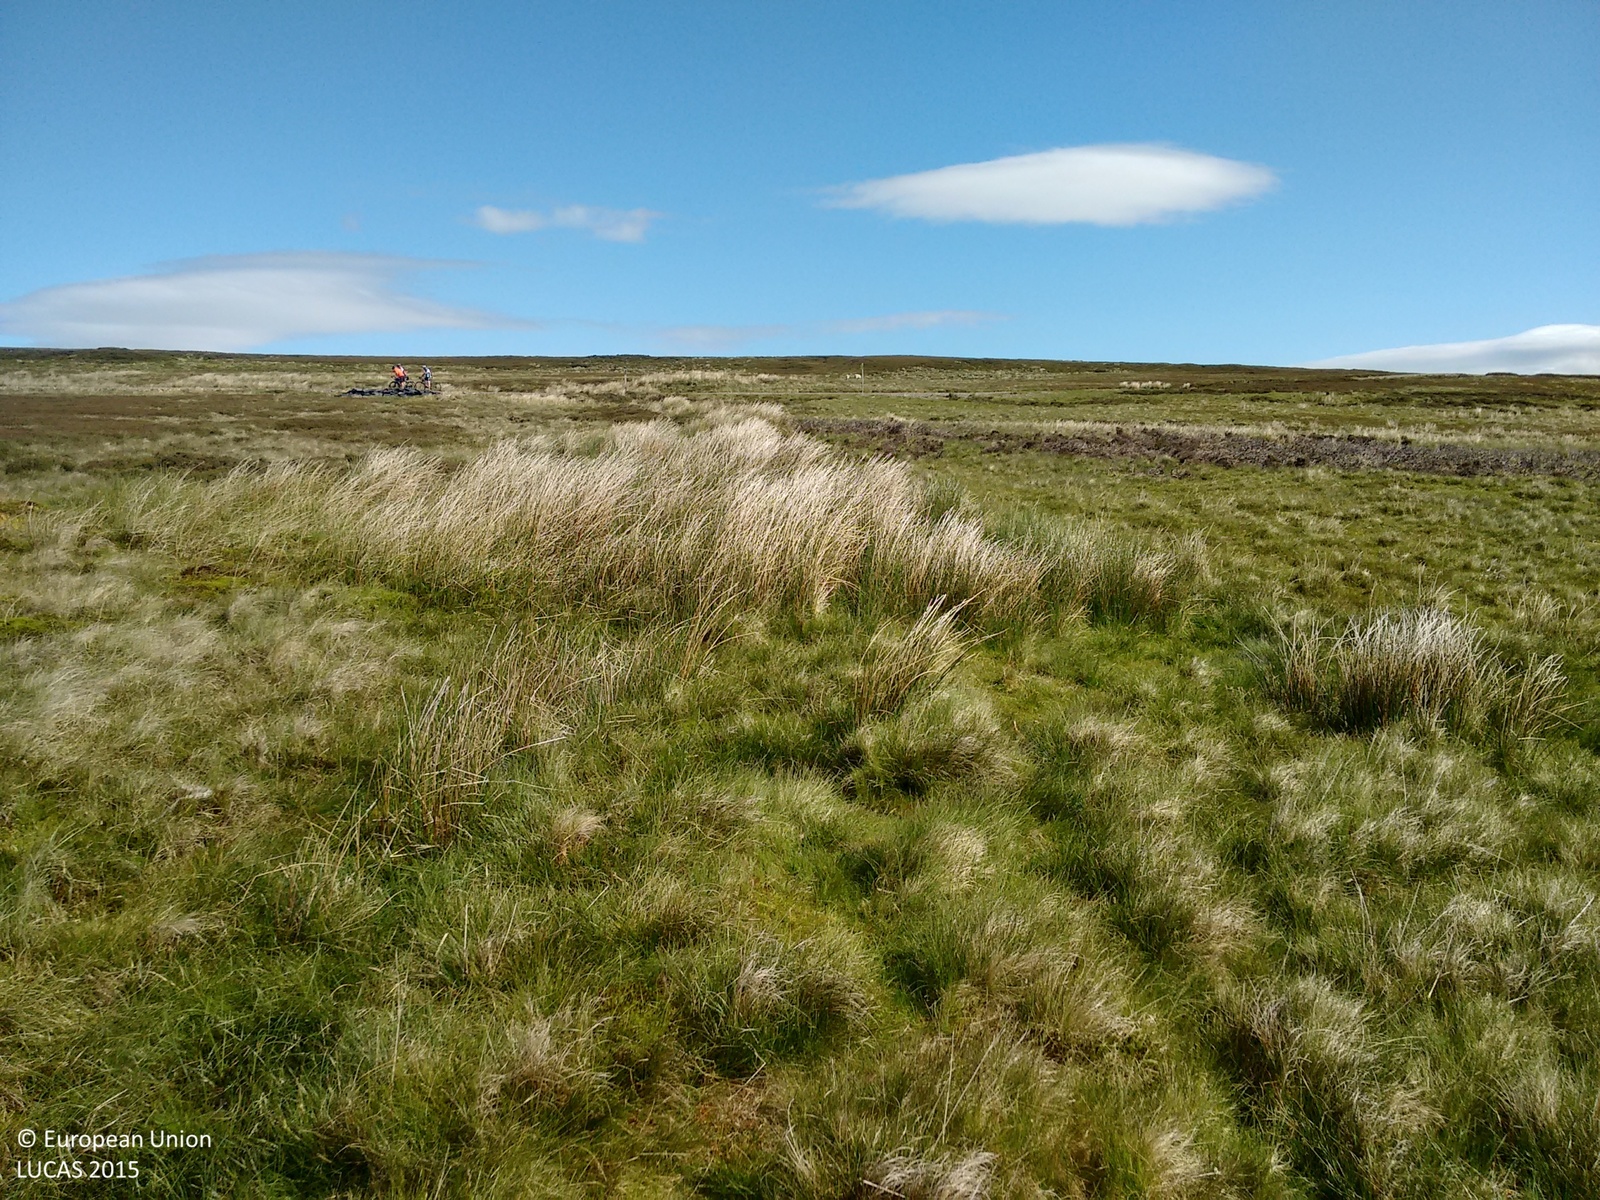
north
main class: Grassland
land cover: Grassland without tree/shrub cover
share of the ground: > 75 %
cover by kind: herbaceous plants 100 %
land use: Agriculture (excluding fallow land and kitchen gardens)
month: June
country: GB
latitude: 54.7986
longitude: -2.0488
